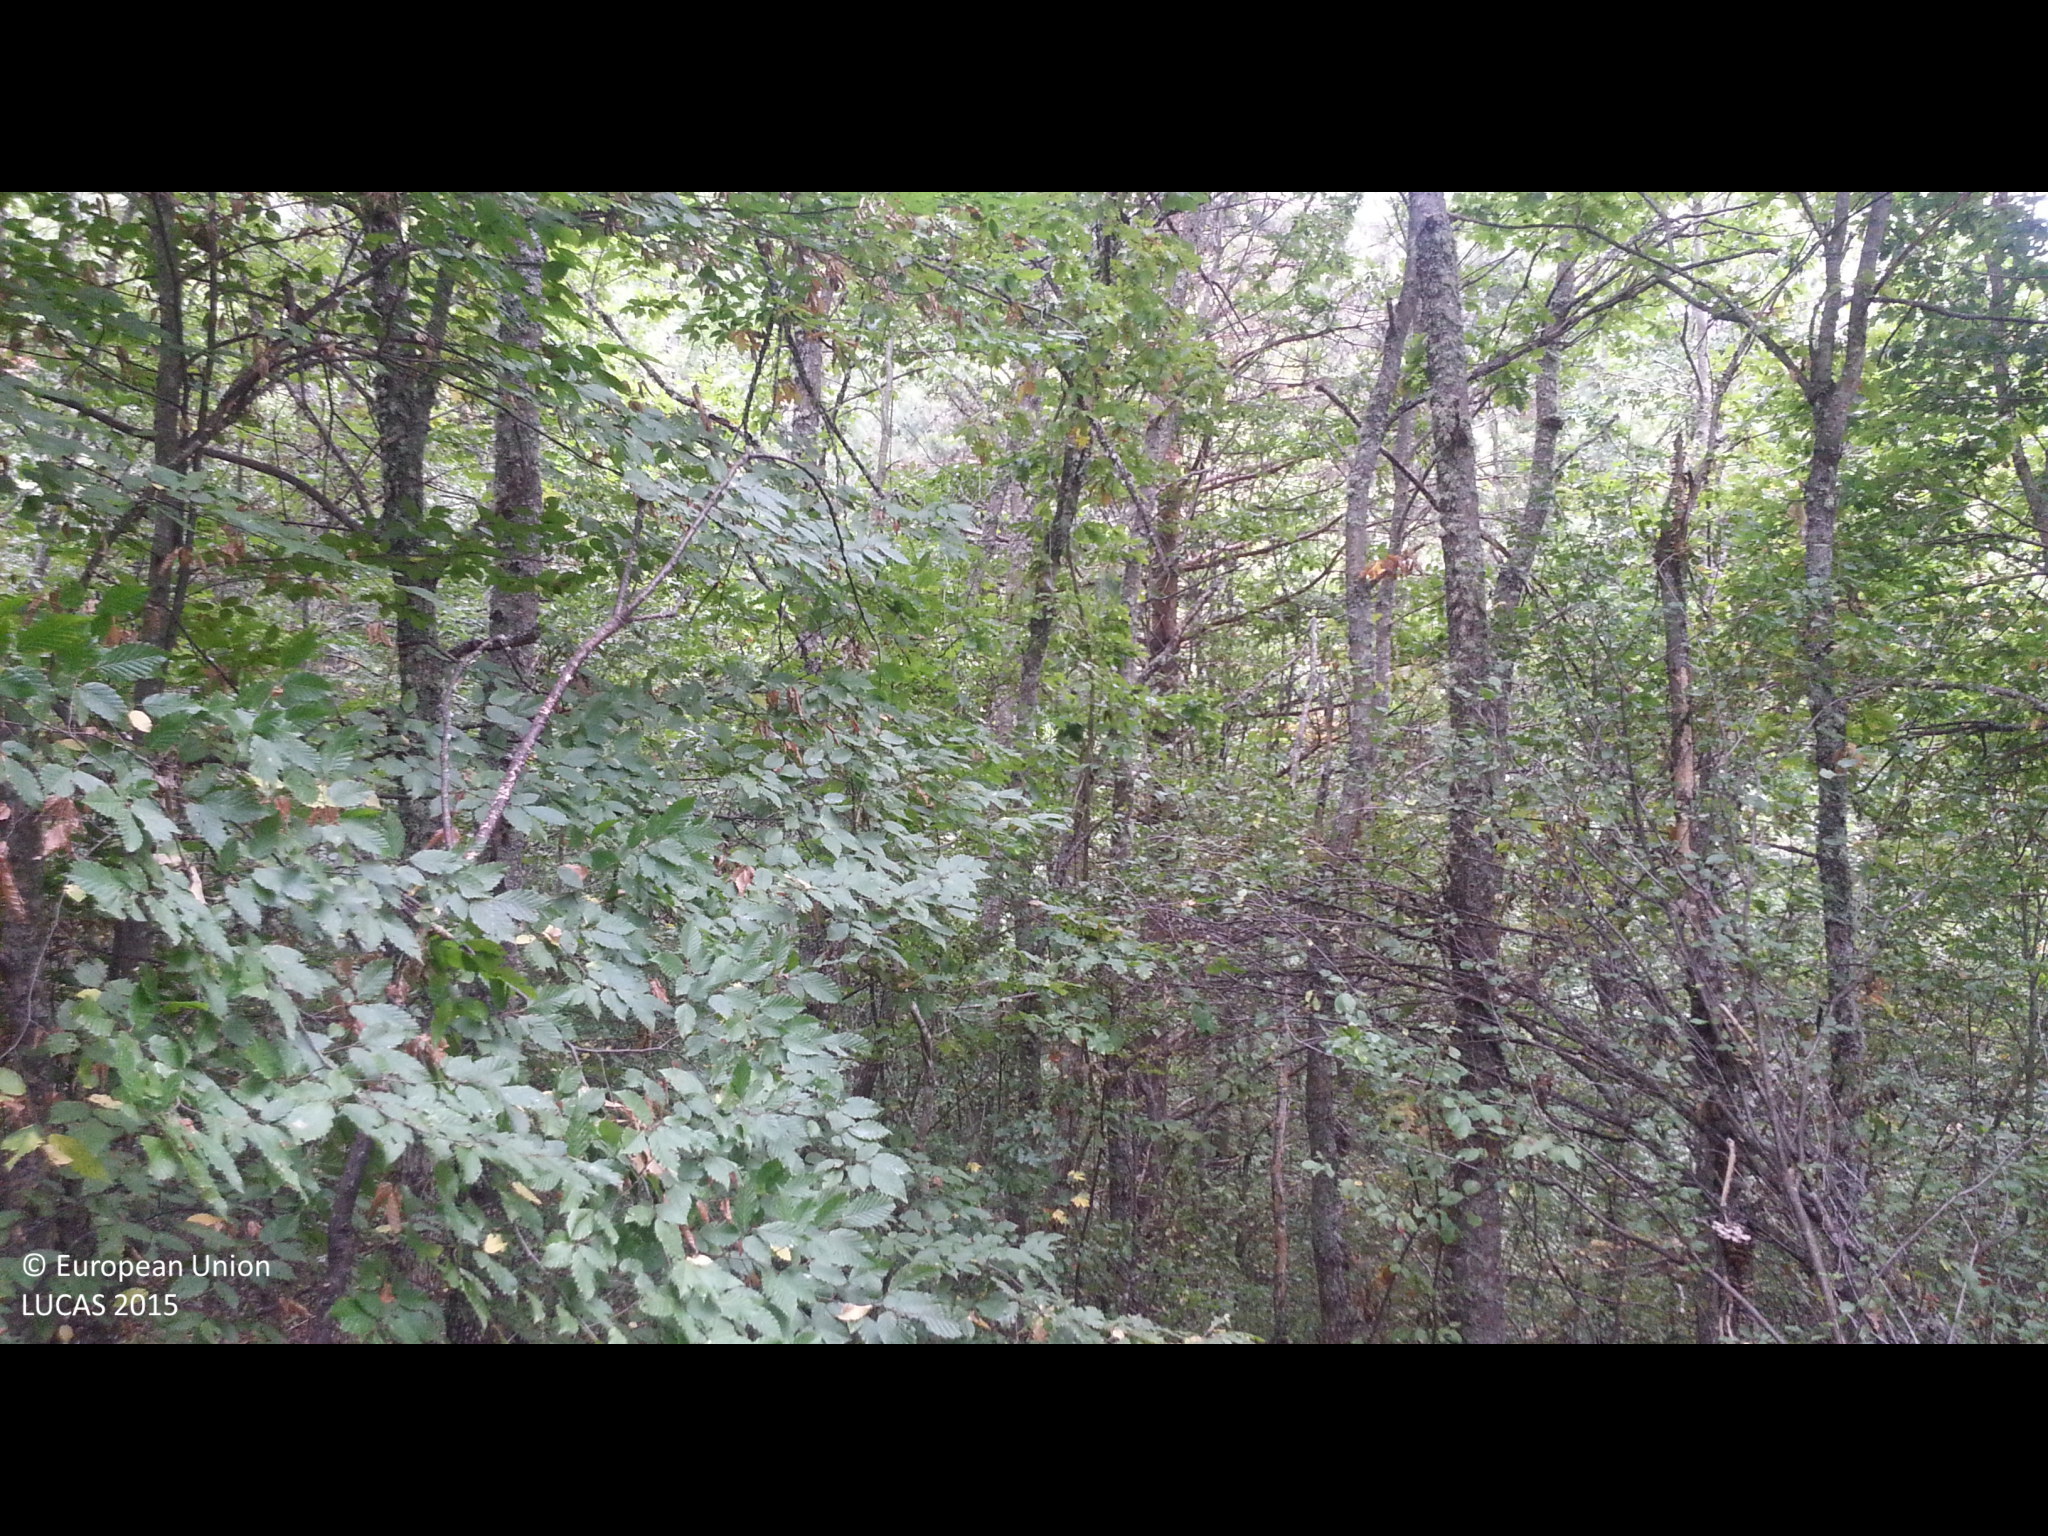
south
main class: Woodland
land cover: Broadleaved woodland
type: mesophytic deciduous forest
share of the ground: > 75 %
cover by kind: broadleaved forest trees 90 %, shrubs 10 %
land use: Forestry
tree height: > 5 m
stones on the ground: < 10 %
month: September
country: BG
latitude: 42.3643
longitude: 22.5393
